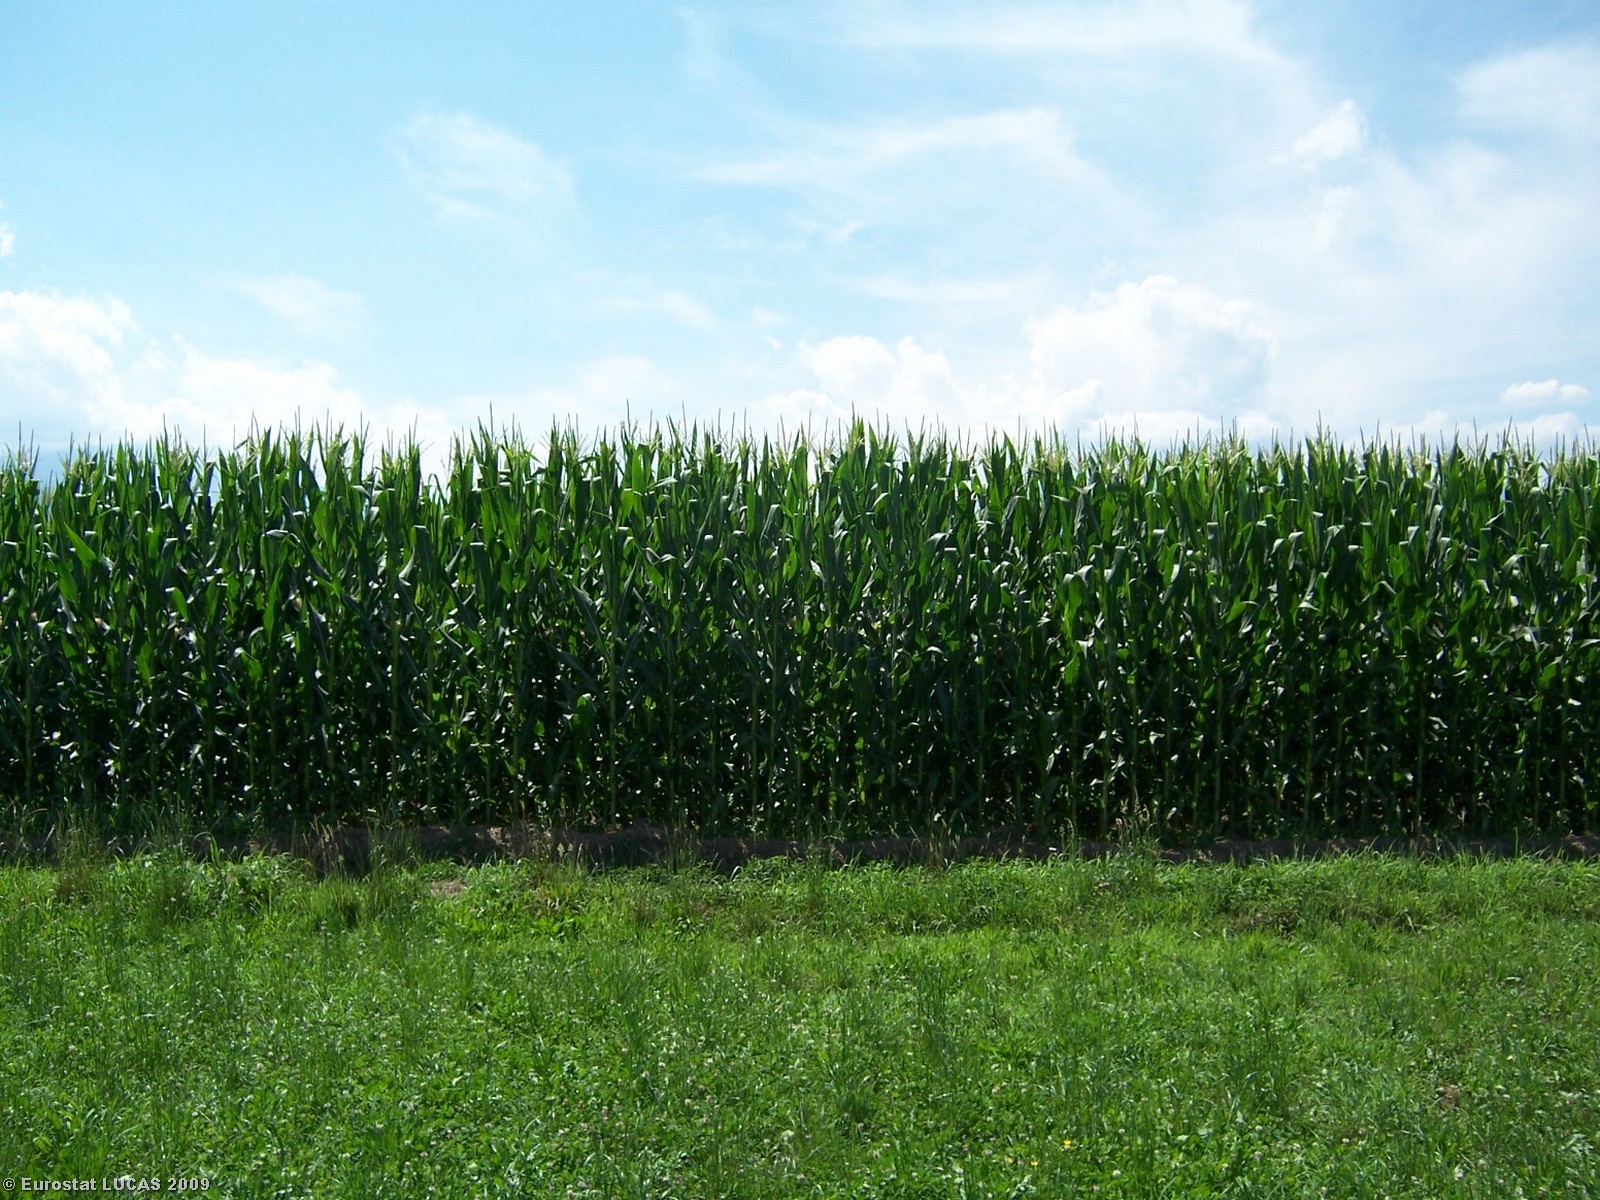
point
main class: Cropland
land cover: Maize
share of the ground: > 75 %
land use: Agriculture (excluding fallow land and kitchen gardens)
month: July
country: IT
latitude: 44.8048
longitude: 7.3877
